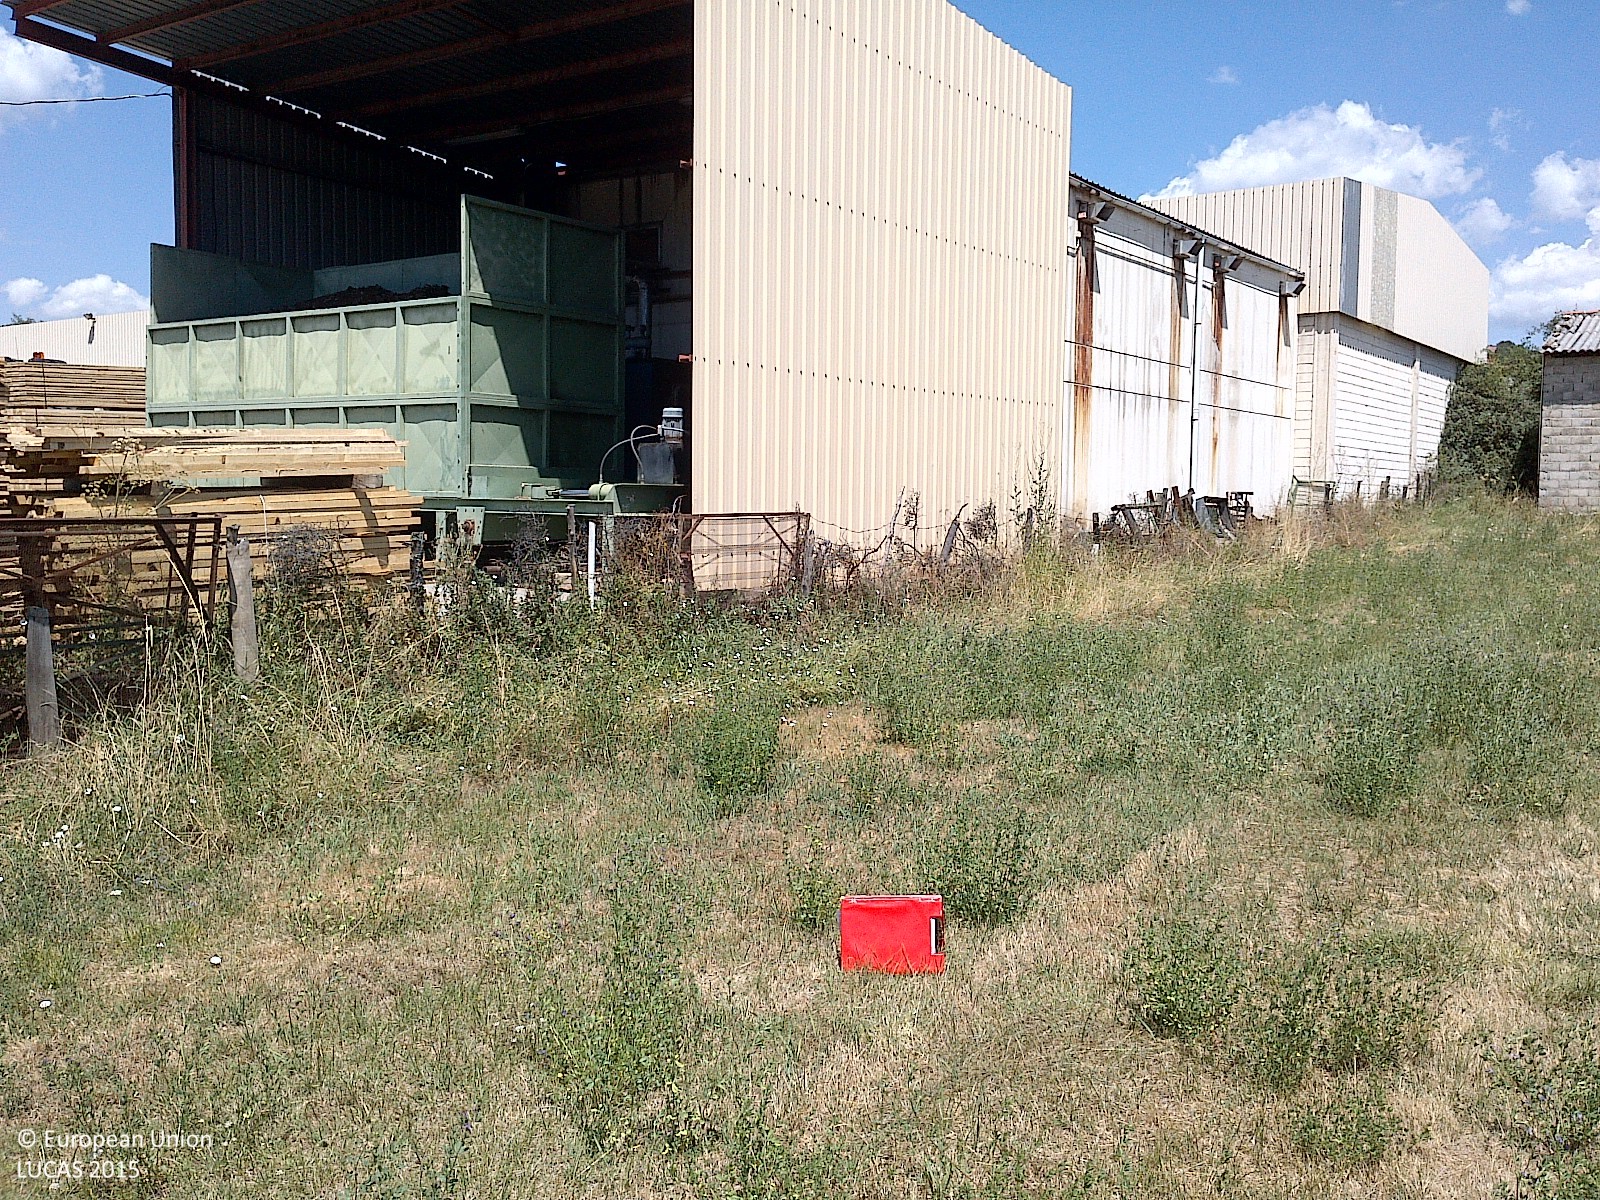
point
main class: Grassland
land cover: Grassland without tree/shrub cover
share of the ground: > 75 %
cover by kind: herbaceous plants 100 %
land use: Semi-natural and natural areas not in use
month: July
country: ES
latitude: 41.8456
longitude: -3.1631
